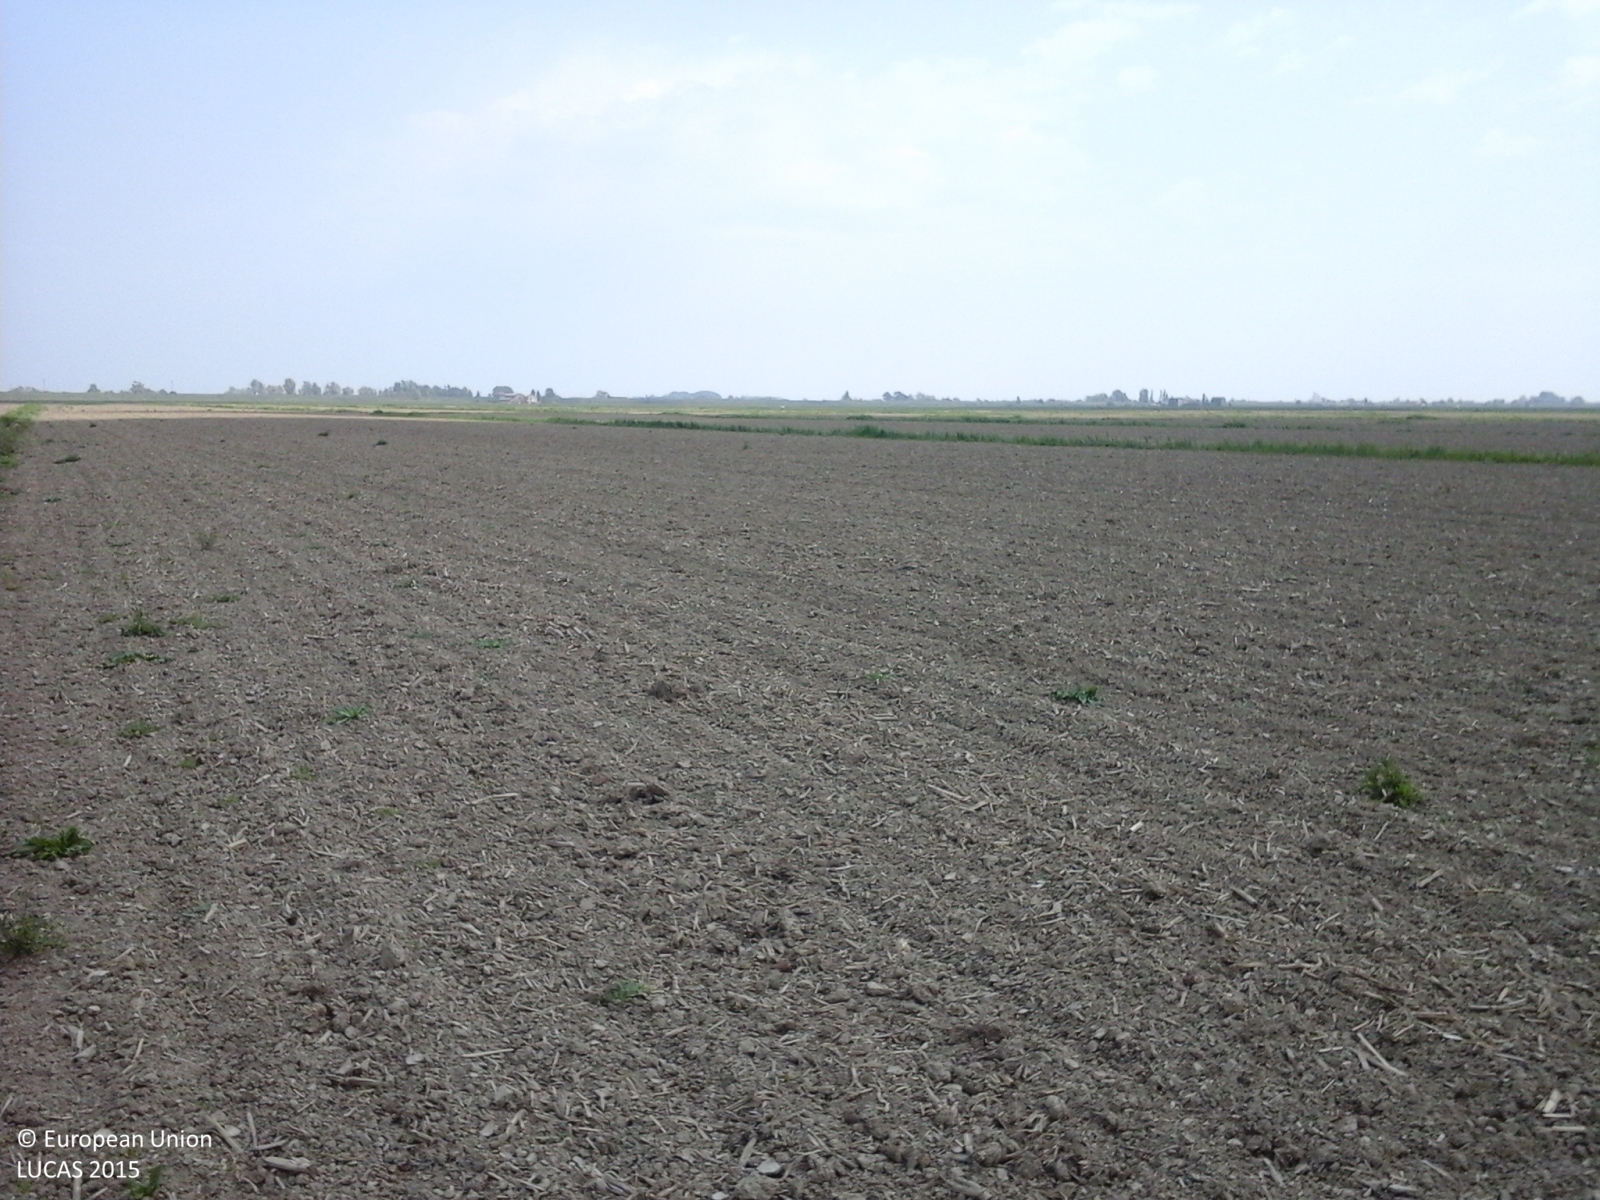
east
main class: Cropland
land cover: Maize
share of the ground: < 10 %
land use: Agriculture (excluding fallow land and kitchen gardens)
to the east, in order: Maize; Ditches and canals; Maize; Ditches and canals; Maize; Grass margins; Ditches and canals
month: April
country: IT
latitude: 44.8655
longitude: 12.3371
